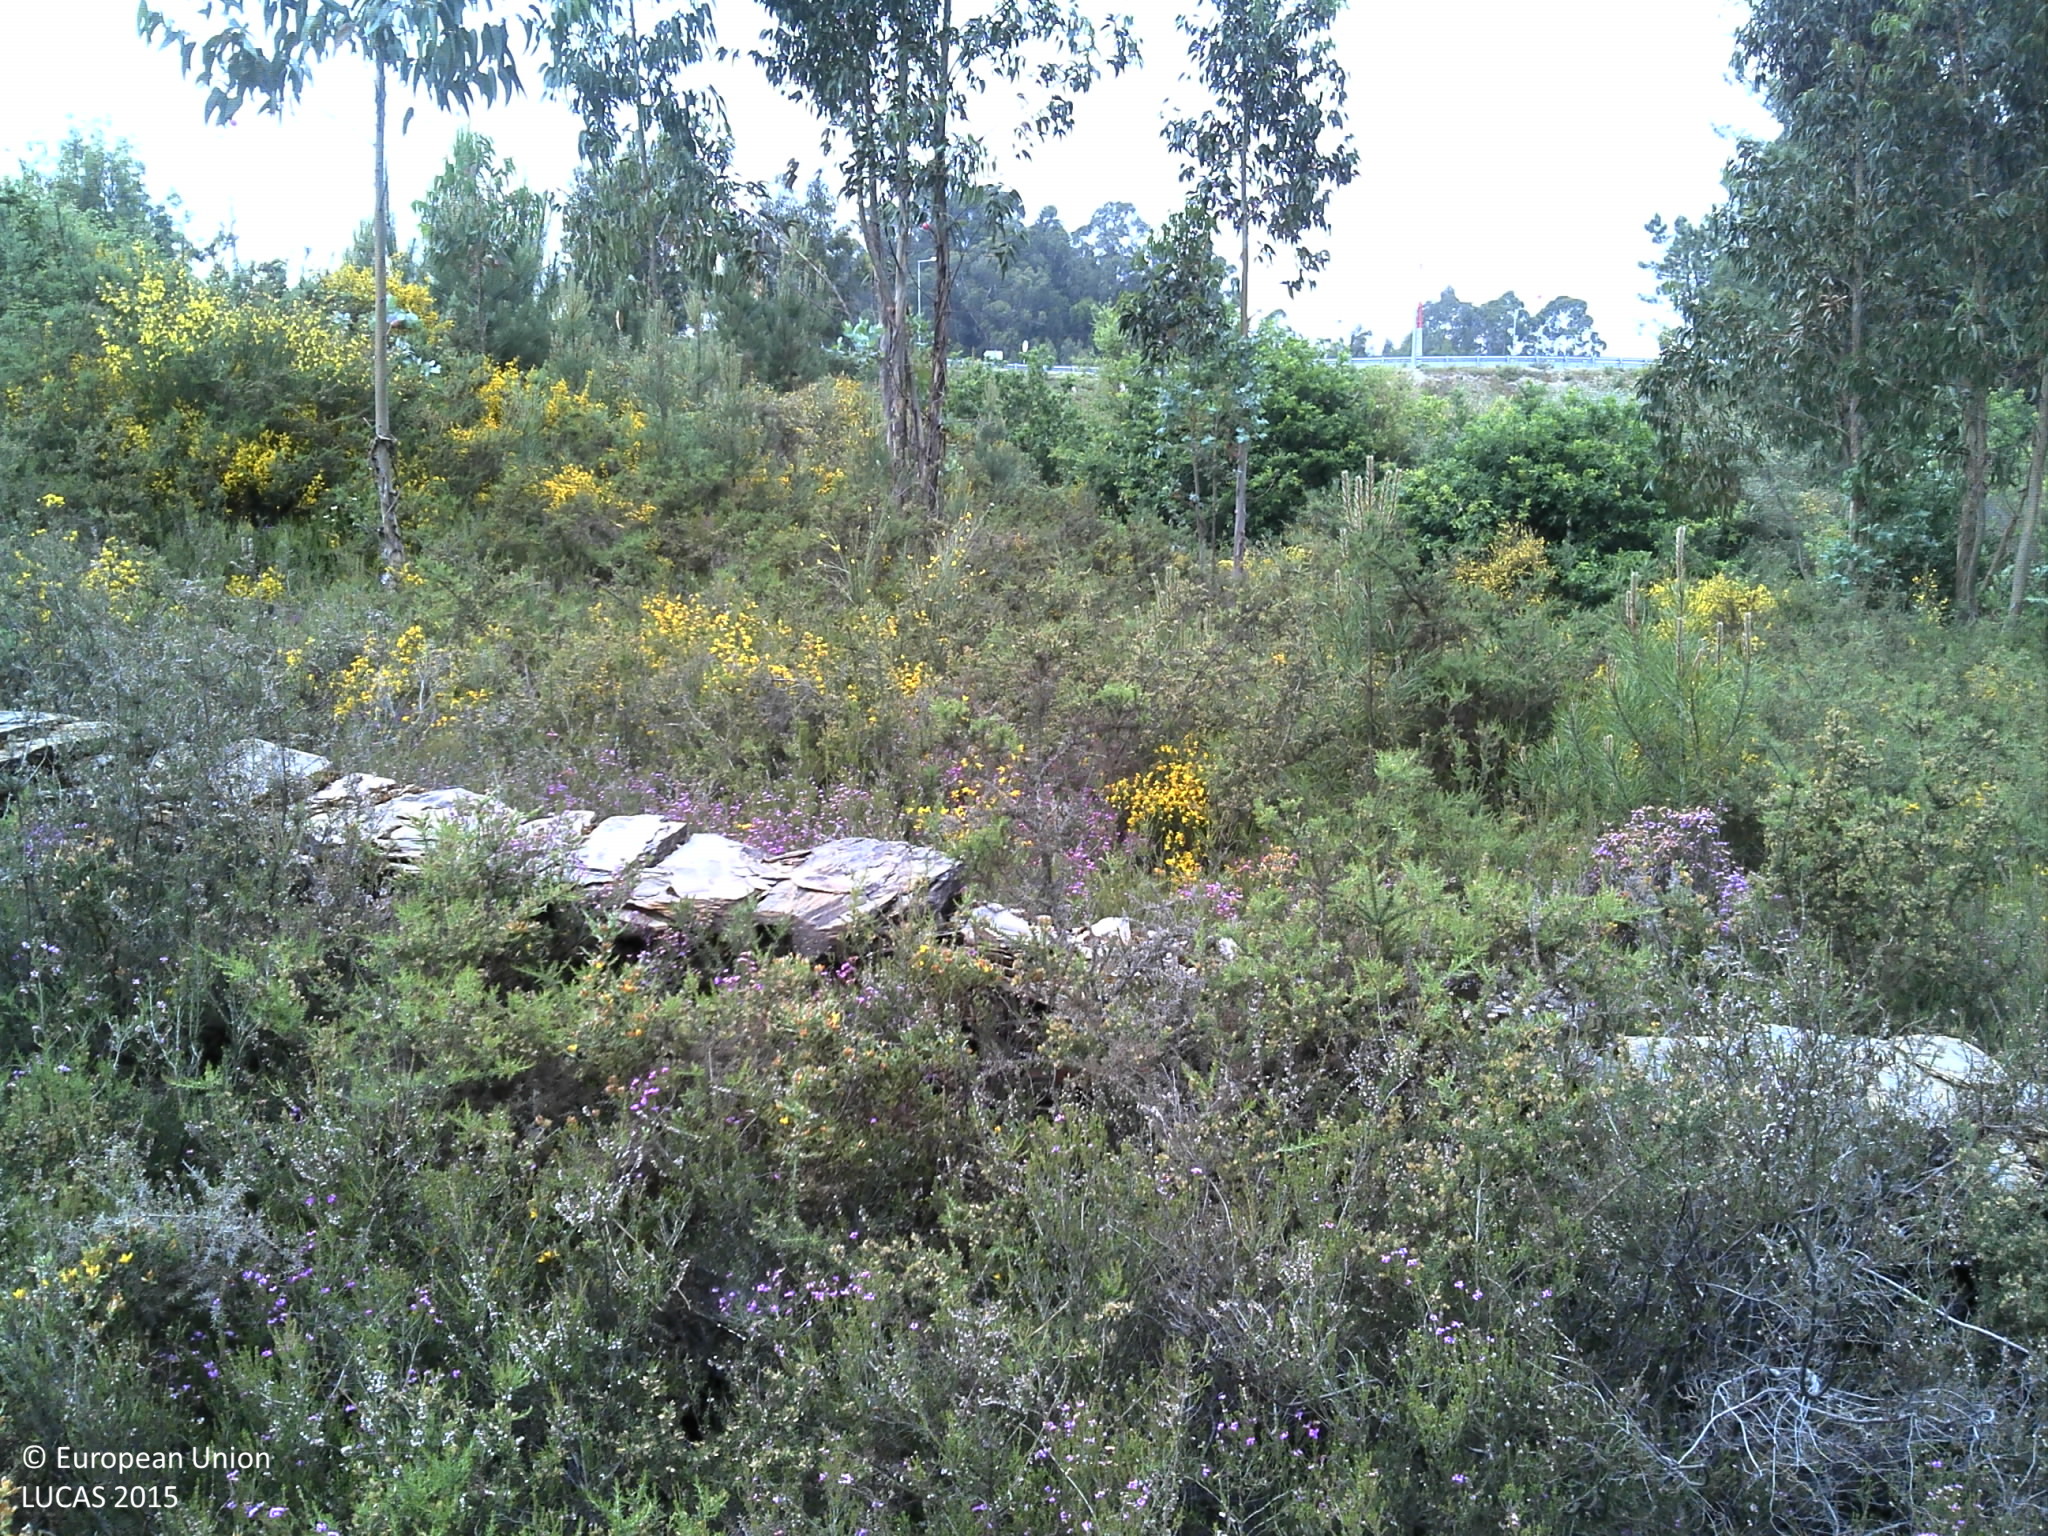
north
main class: Shrubland
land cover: Shrubland with sparse tree cover
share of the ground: > 75 %
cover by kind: shrubs 85 %, unconsolidated bare surface 10 %, broadleaved forest trees 5 %
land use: Forestry
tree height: > 5 m
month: May
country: PT
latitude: 41.1648
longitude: -8.4423
